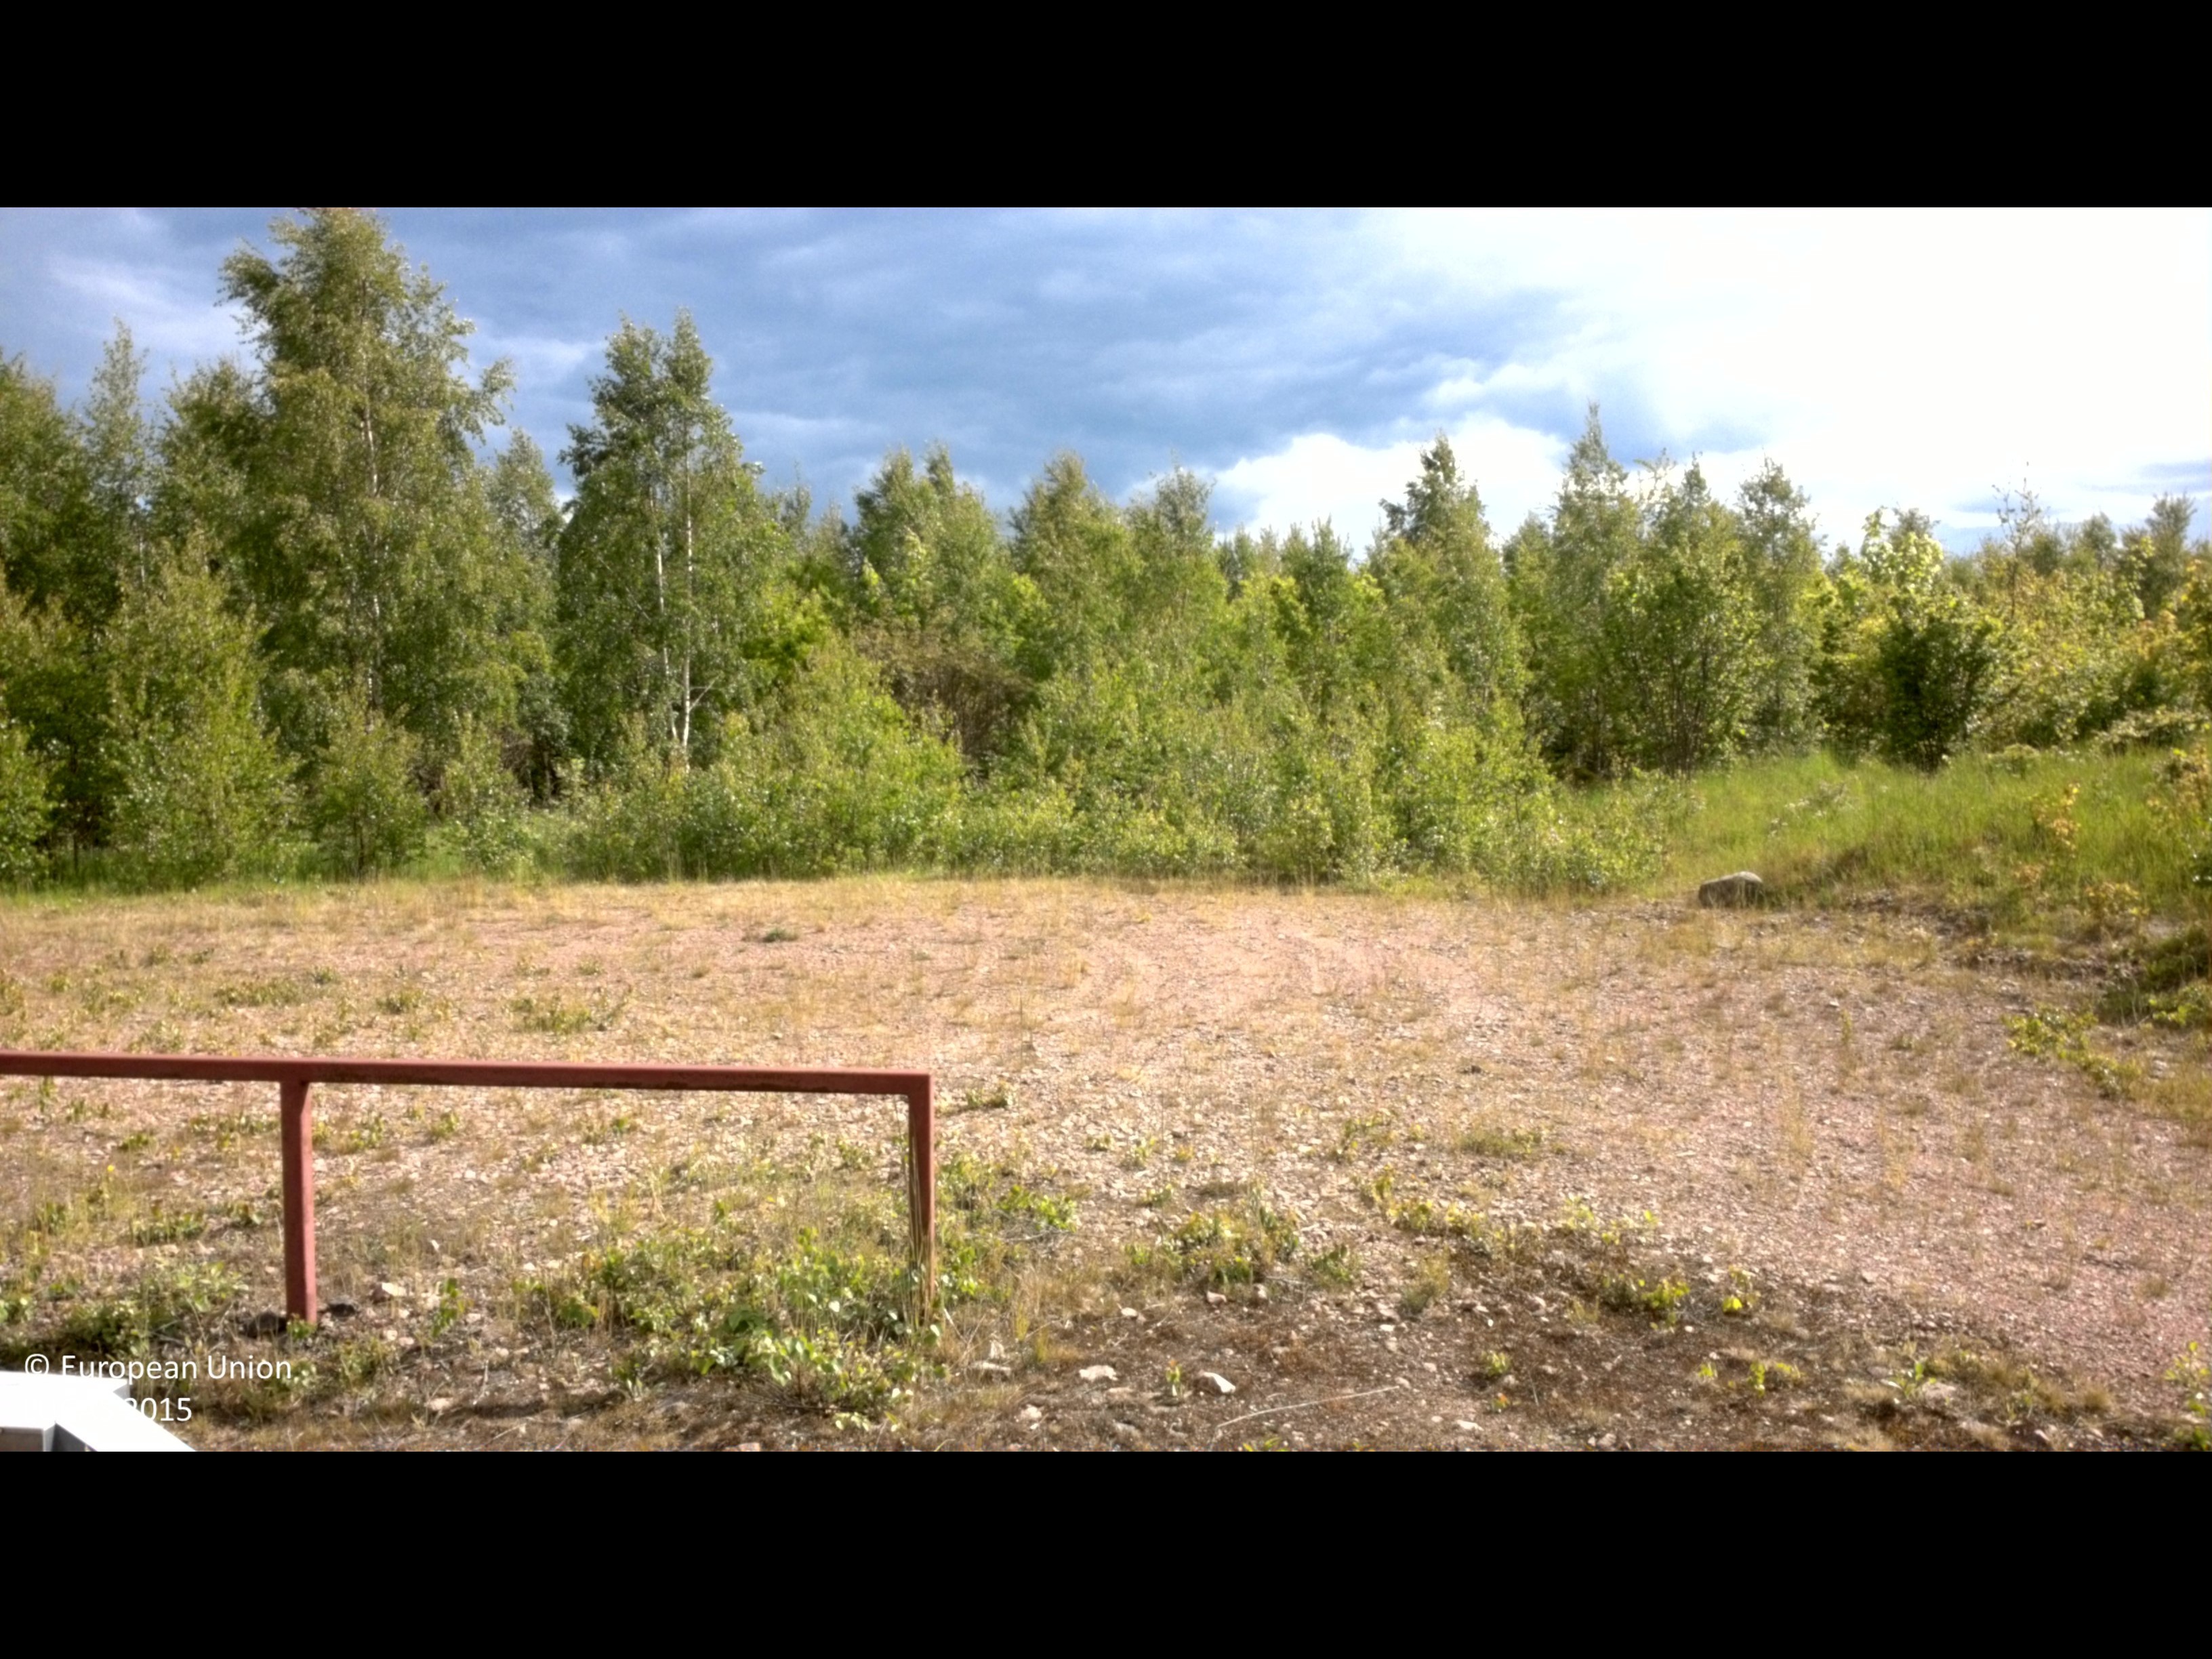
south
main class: Shrubland
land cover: Shrubland with sparse tree cover
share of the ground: > 75 %
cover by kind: shrubs 45 %, unconsolidated bare surface 30 %, herbaceous plants 10 %, broadleaved forest trees 5 %
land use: Air transport
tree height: < 5 m
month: May
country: SE
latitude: 57.3405
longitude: 16.4960
